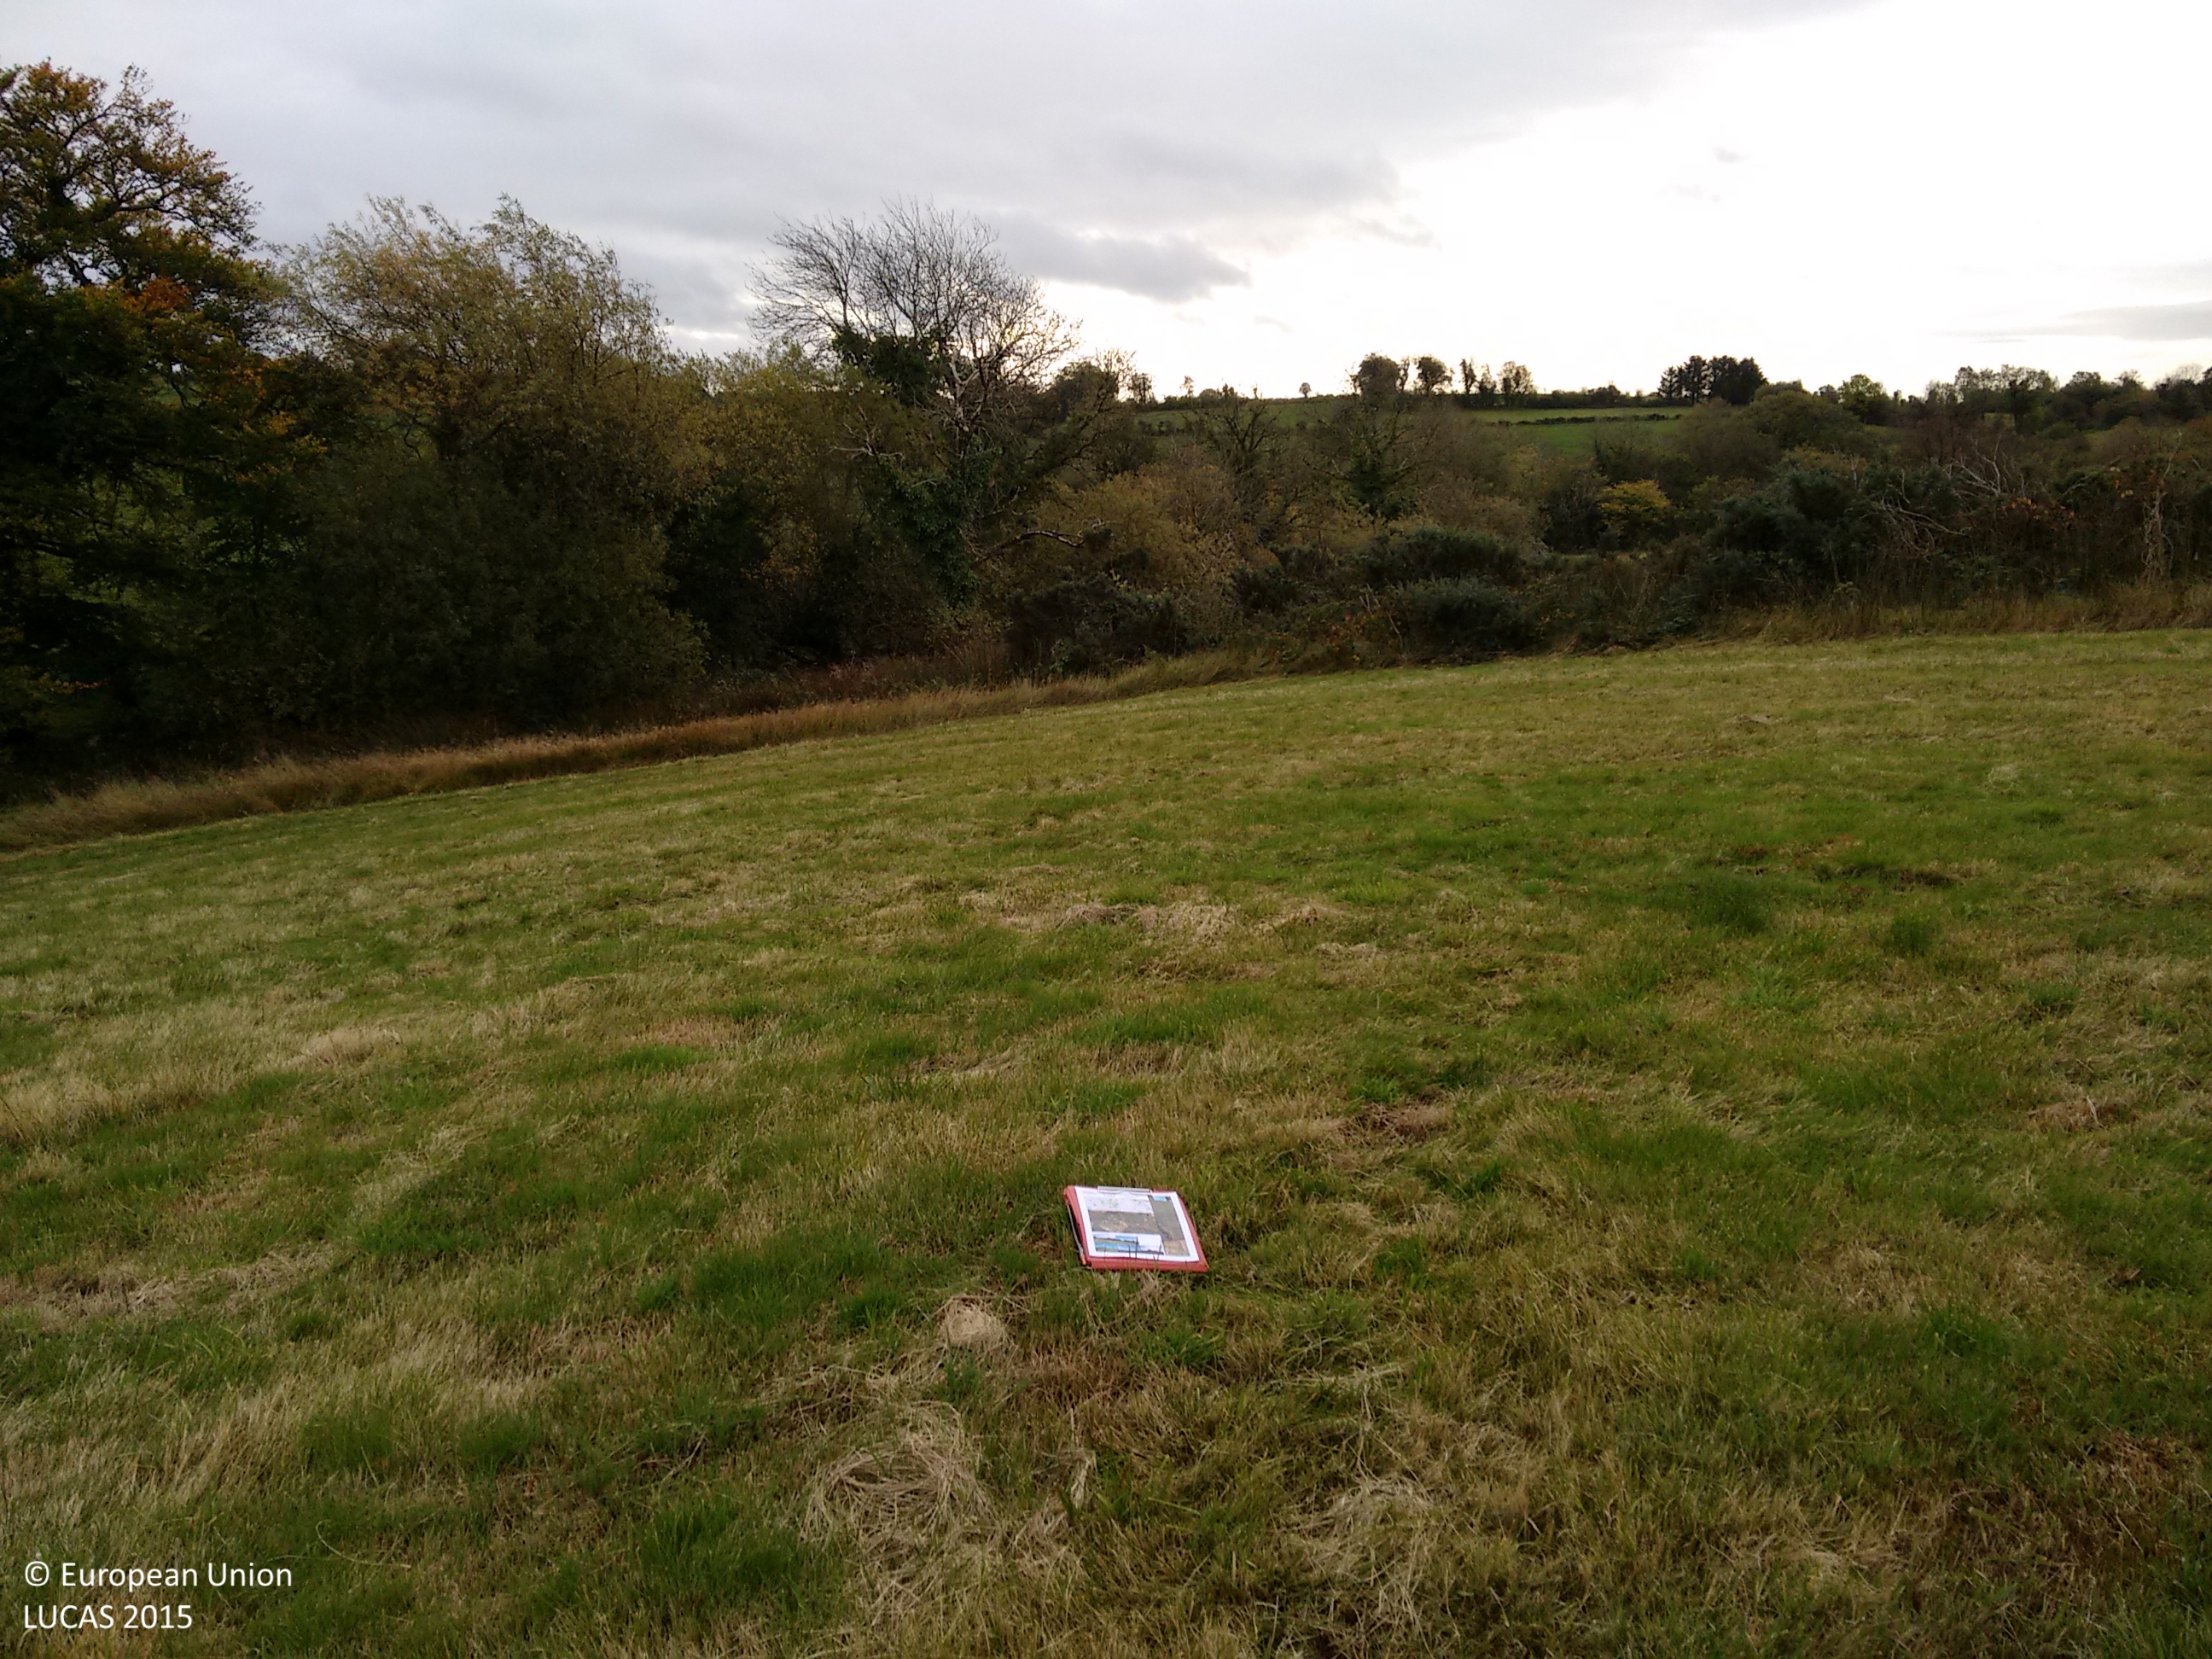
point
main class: Grassland
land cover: Grassland without tree/shrub cover
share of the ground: > 75 %
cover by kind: herbaceous plants 100 %
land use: Agriculture (excluding fallow land and kitchen gardens)
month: October
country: GB
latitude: 54.2660
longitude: -7.3952
